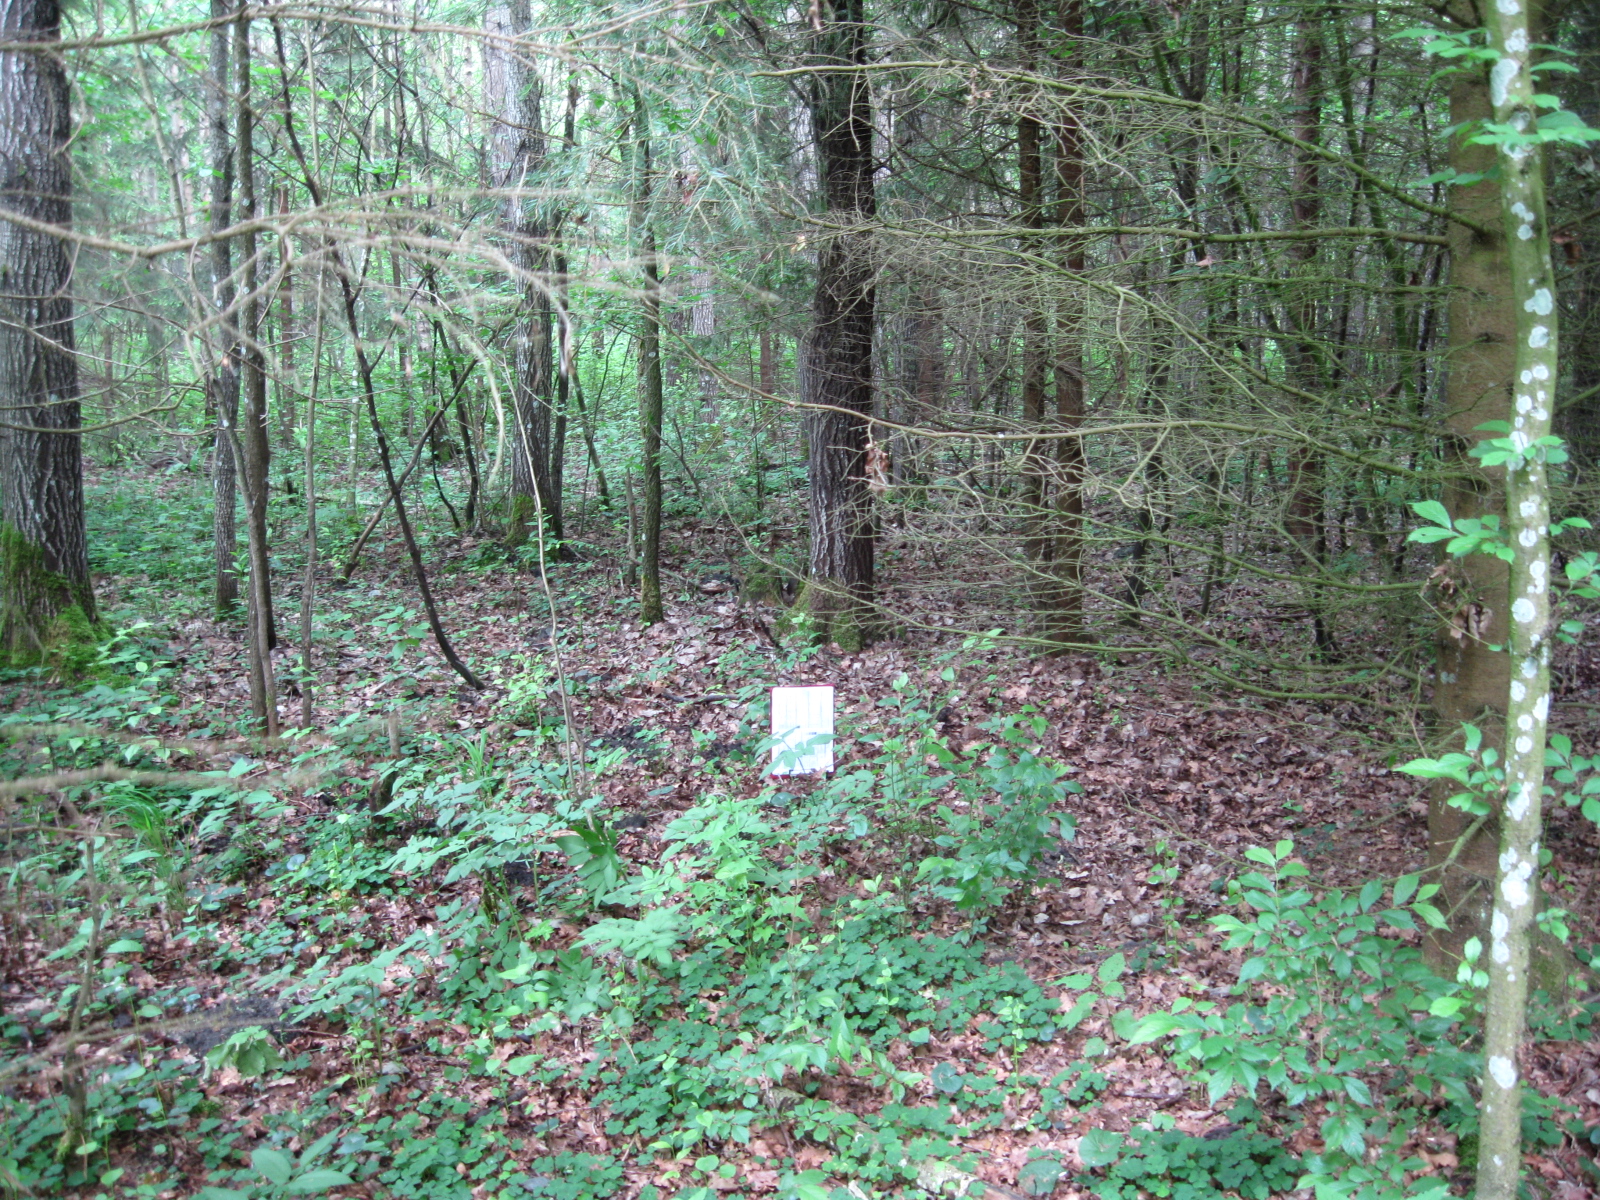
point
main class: Woodland
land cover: Spruce dominated mixed woodland
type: hemiboreal forest and nemoral coniferous forest and mixed broadleaved-coniferous forest
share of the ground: > 75 %
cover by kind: broadleaved forest trees 50 %, coniferous forest trees 40 %, herbaceous plants 10 %
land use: Forestry
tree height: > 5 m
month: June
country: LT
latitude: 55.1965
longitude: 24.1539
